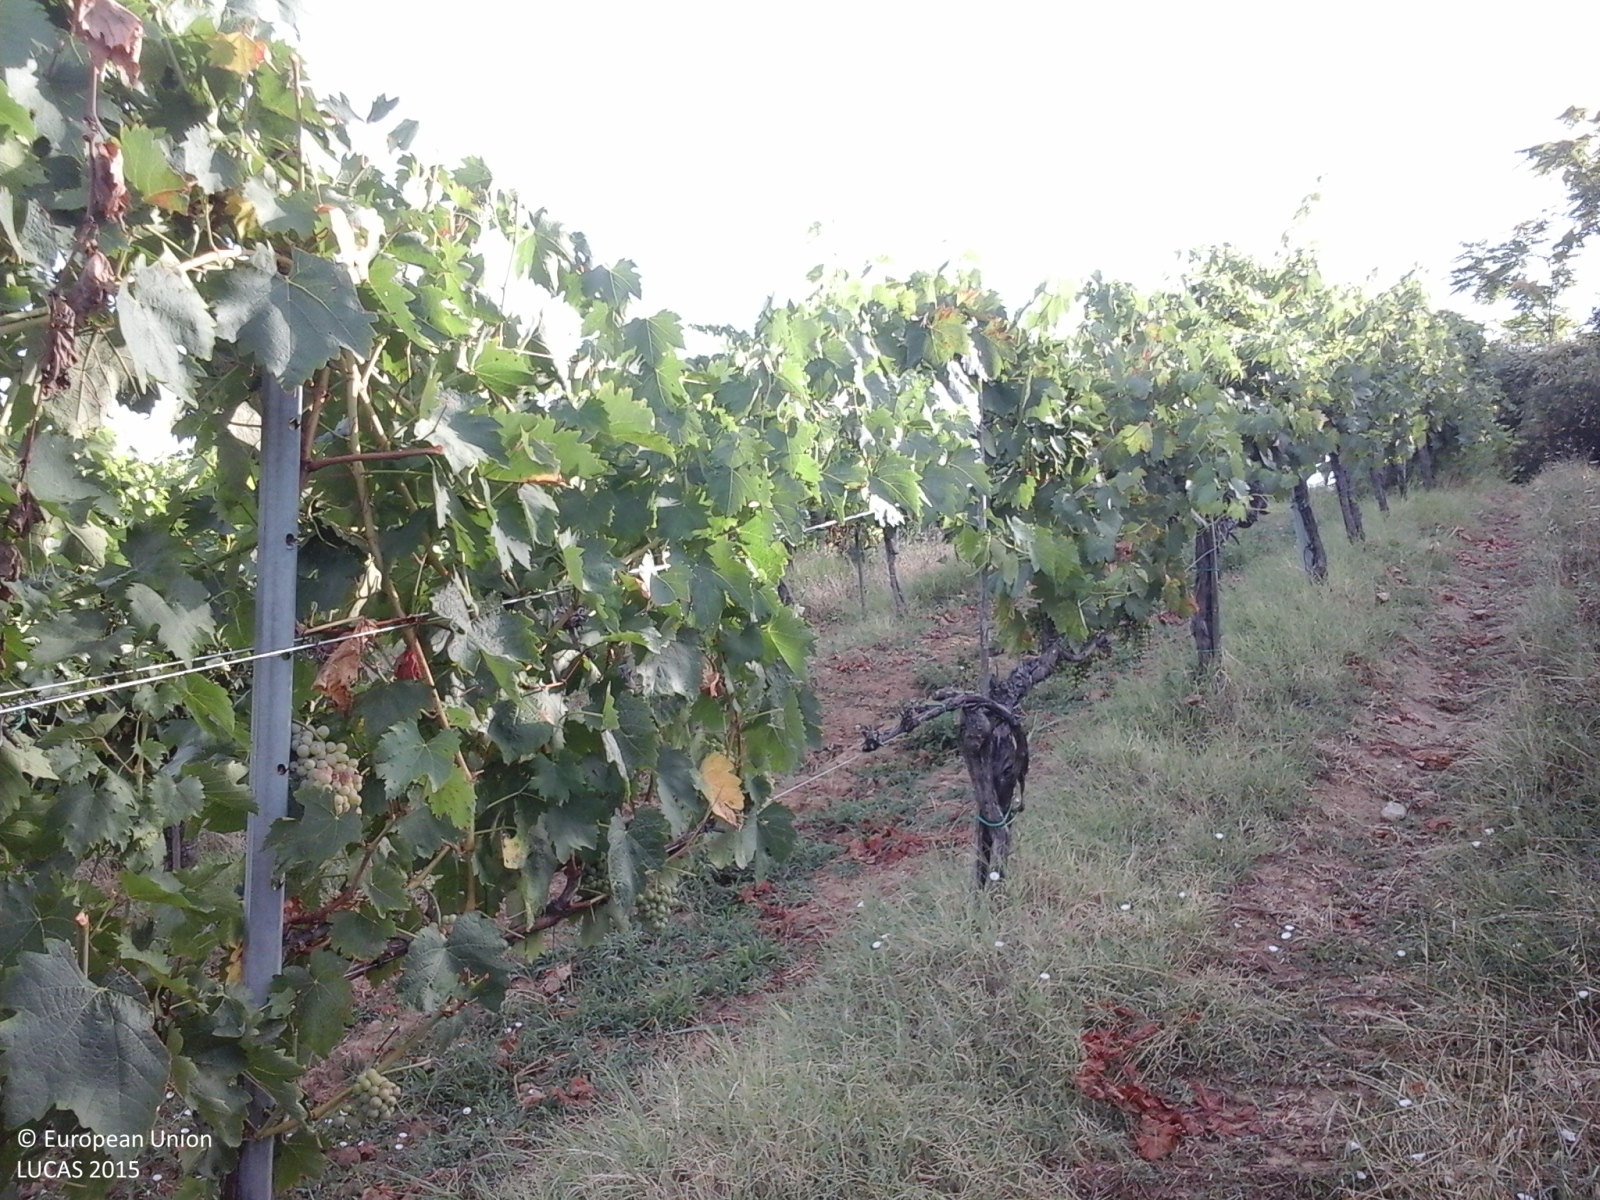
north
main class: Cropland
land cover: Vineyards
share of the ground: > 75 %
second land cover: Grassland without tree/shrub cover
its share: > 75 %
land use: Agriculture (excluding fallow land and kitchen gardens)
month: July
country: IT
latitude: 43.4609
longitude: 11.0723
